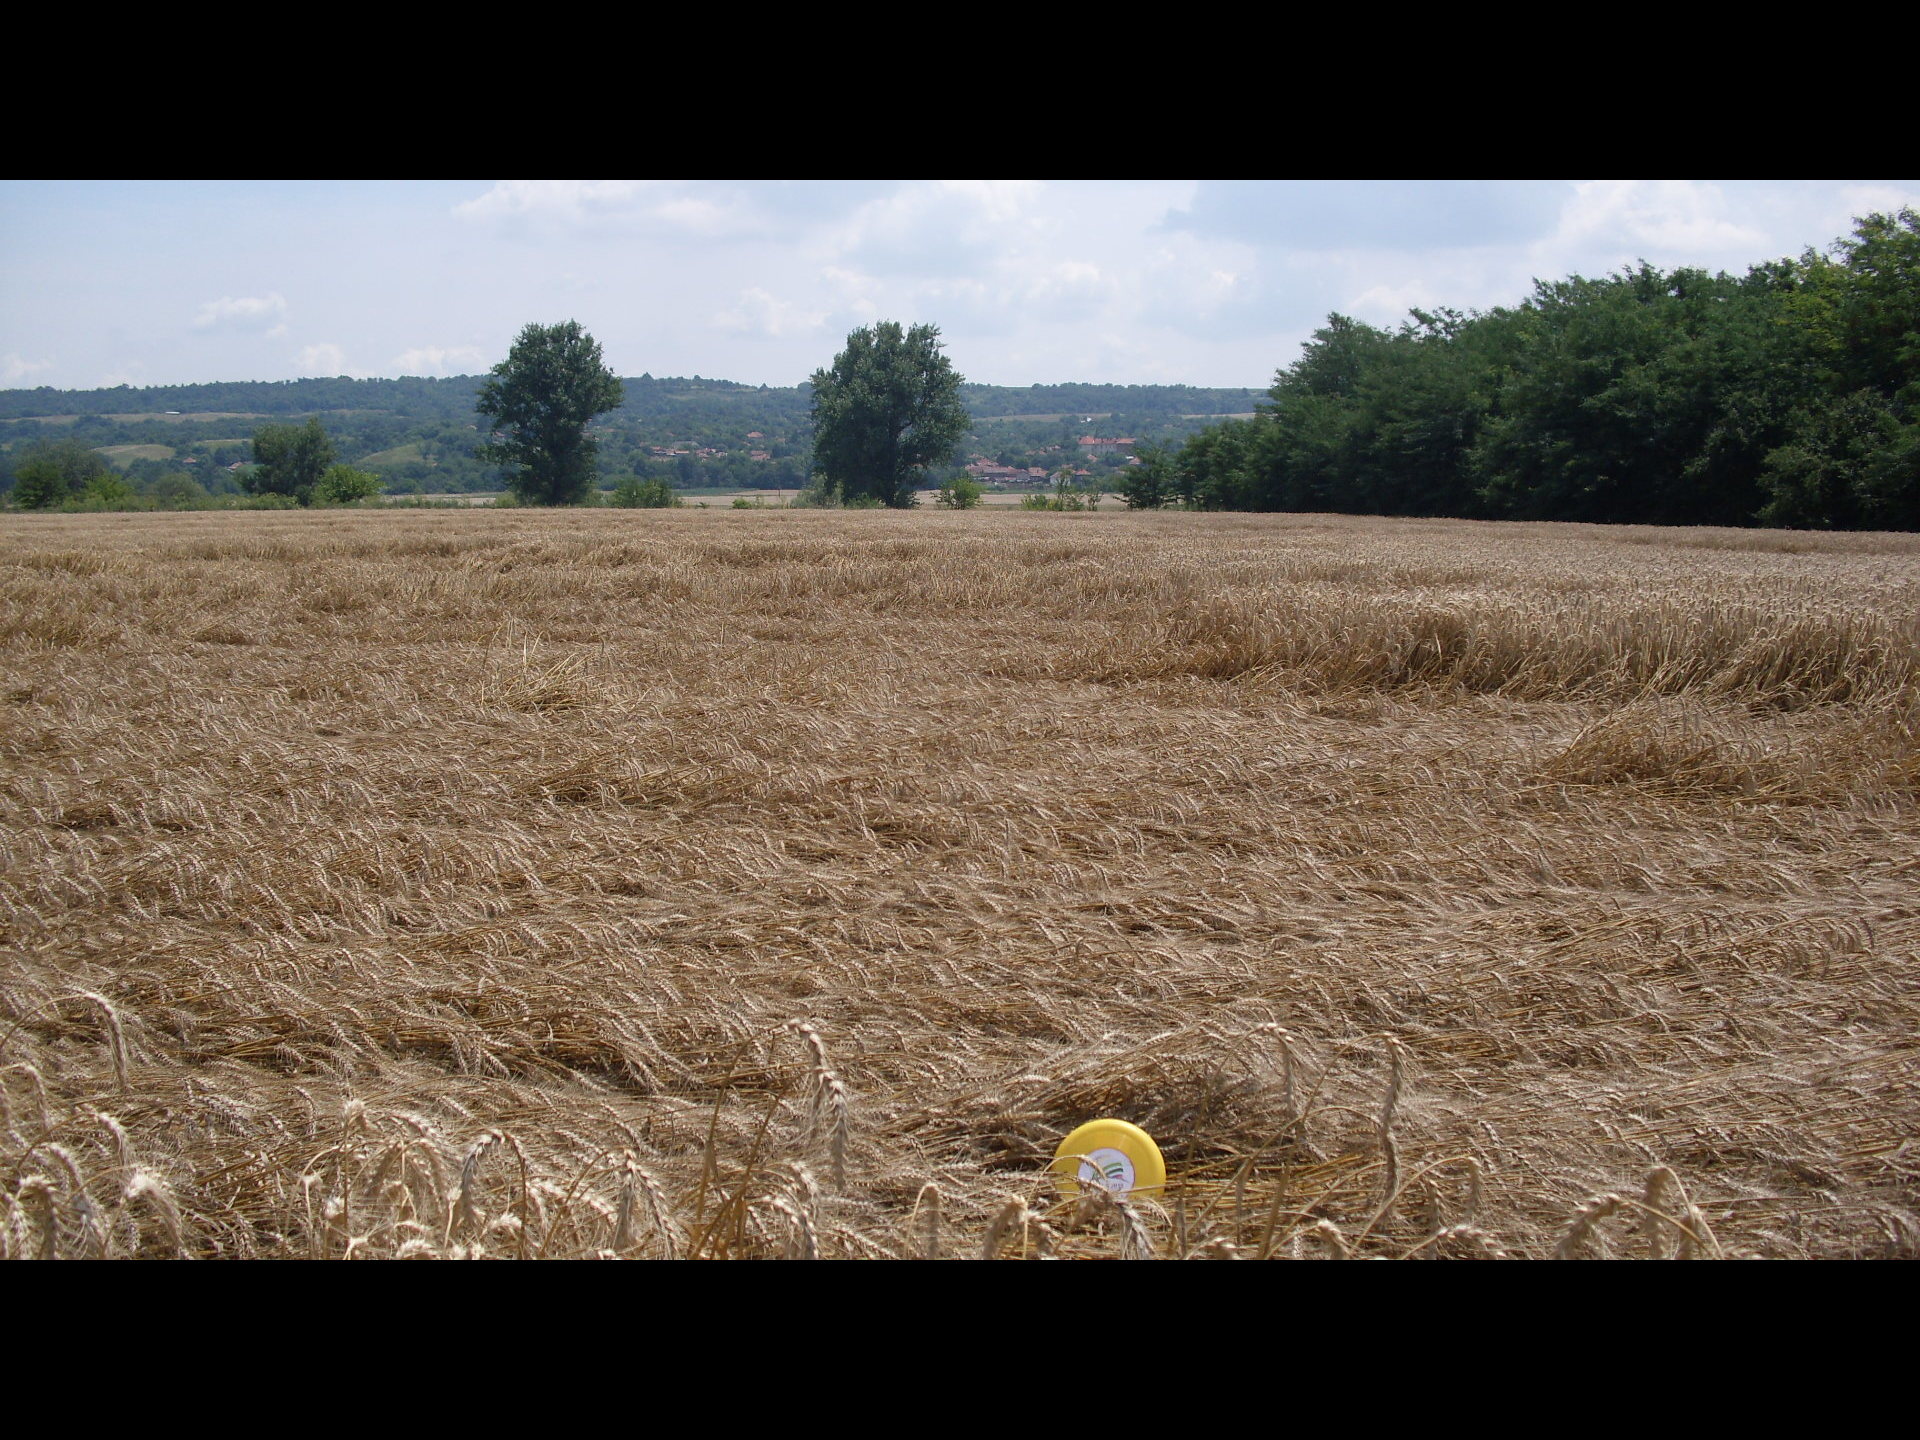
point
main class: Cropland
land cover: Common wheat
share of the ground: > 75 %
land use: Agriculture (excluding fallow land and kitchen gardens)
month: July
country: BG
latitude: 43.7593
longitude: 23.1959
